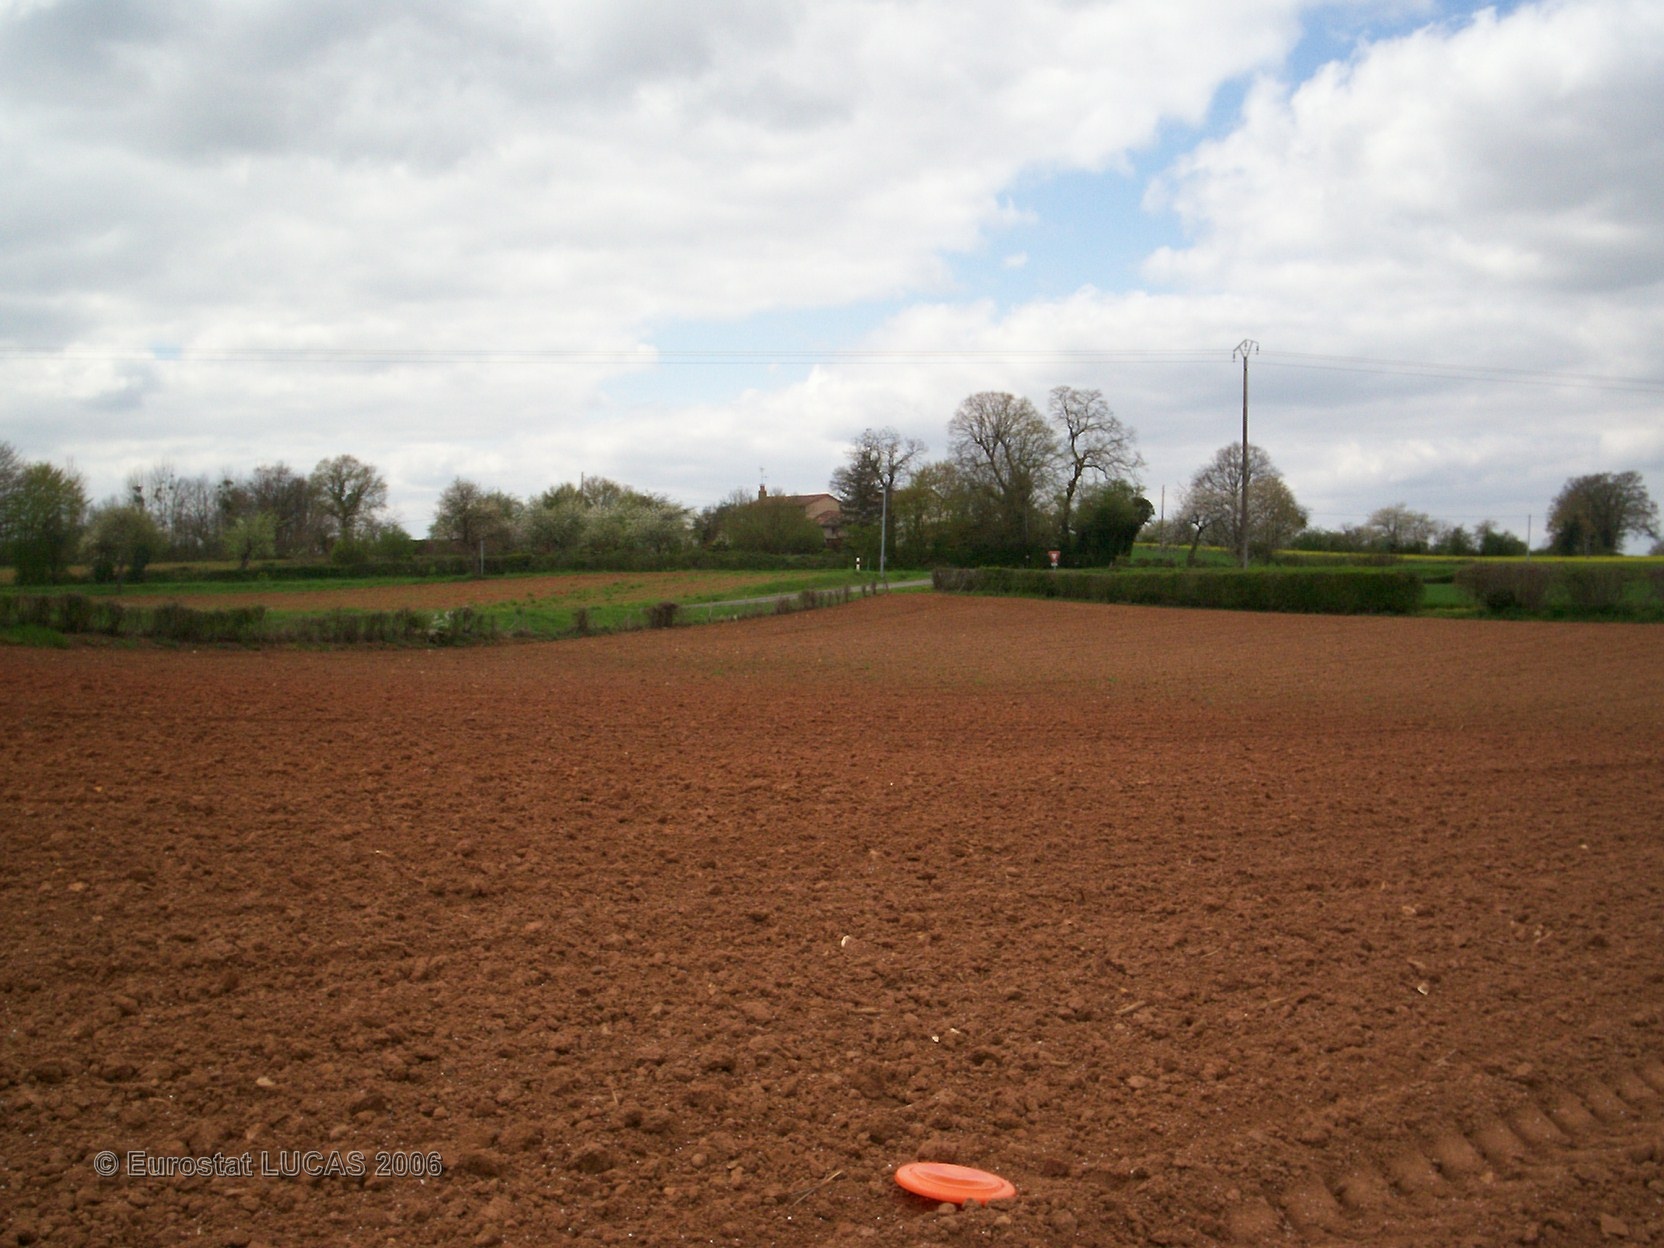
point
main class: Cropland
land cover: Sunflower
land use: Agriculture (excluding fallow land and kitchen gardens)
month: May
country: FR
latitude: 46.2027
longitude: 0.5364
